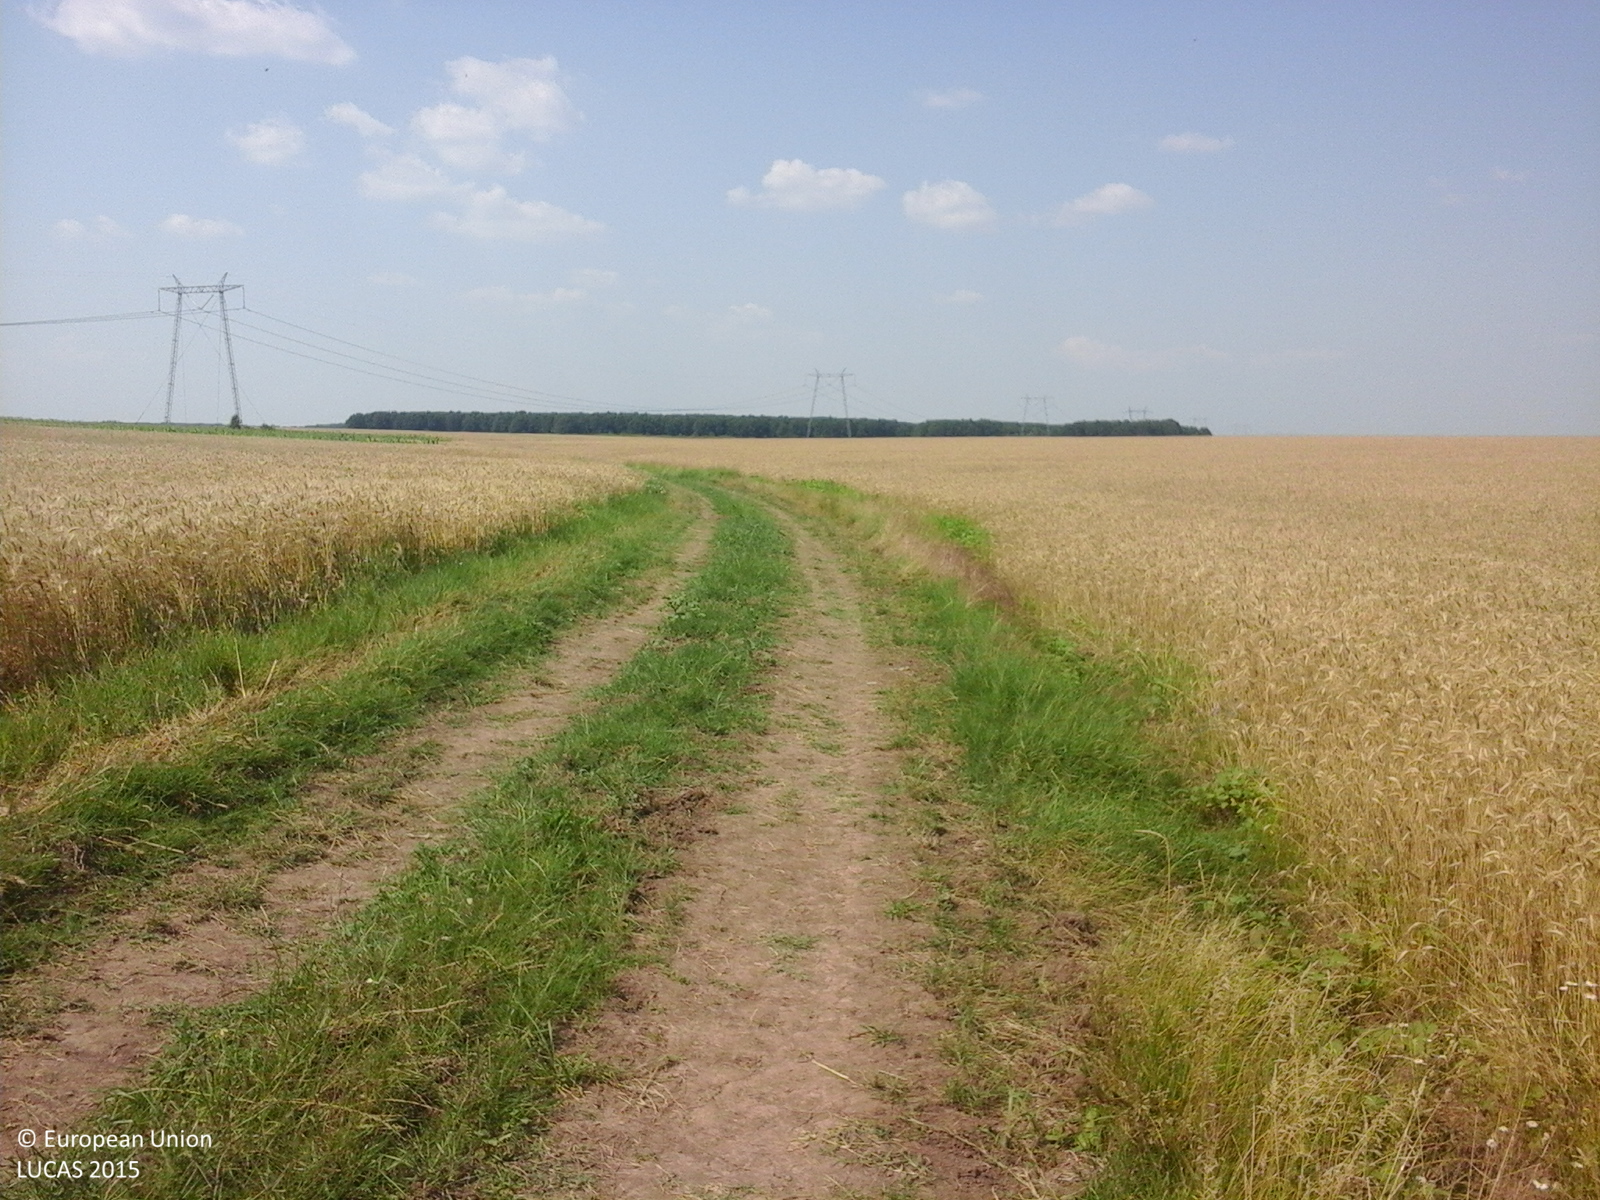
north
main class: Cropland
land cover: Common wheat
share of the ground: > 75 %
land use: Agriculture (excluding fallow land and kitchen gardens)
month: July
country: RO
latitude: 44.6809
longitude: 24.4927
